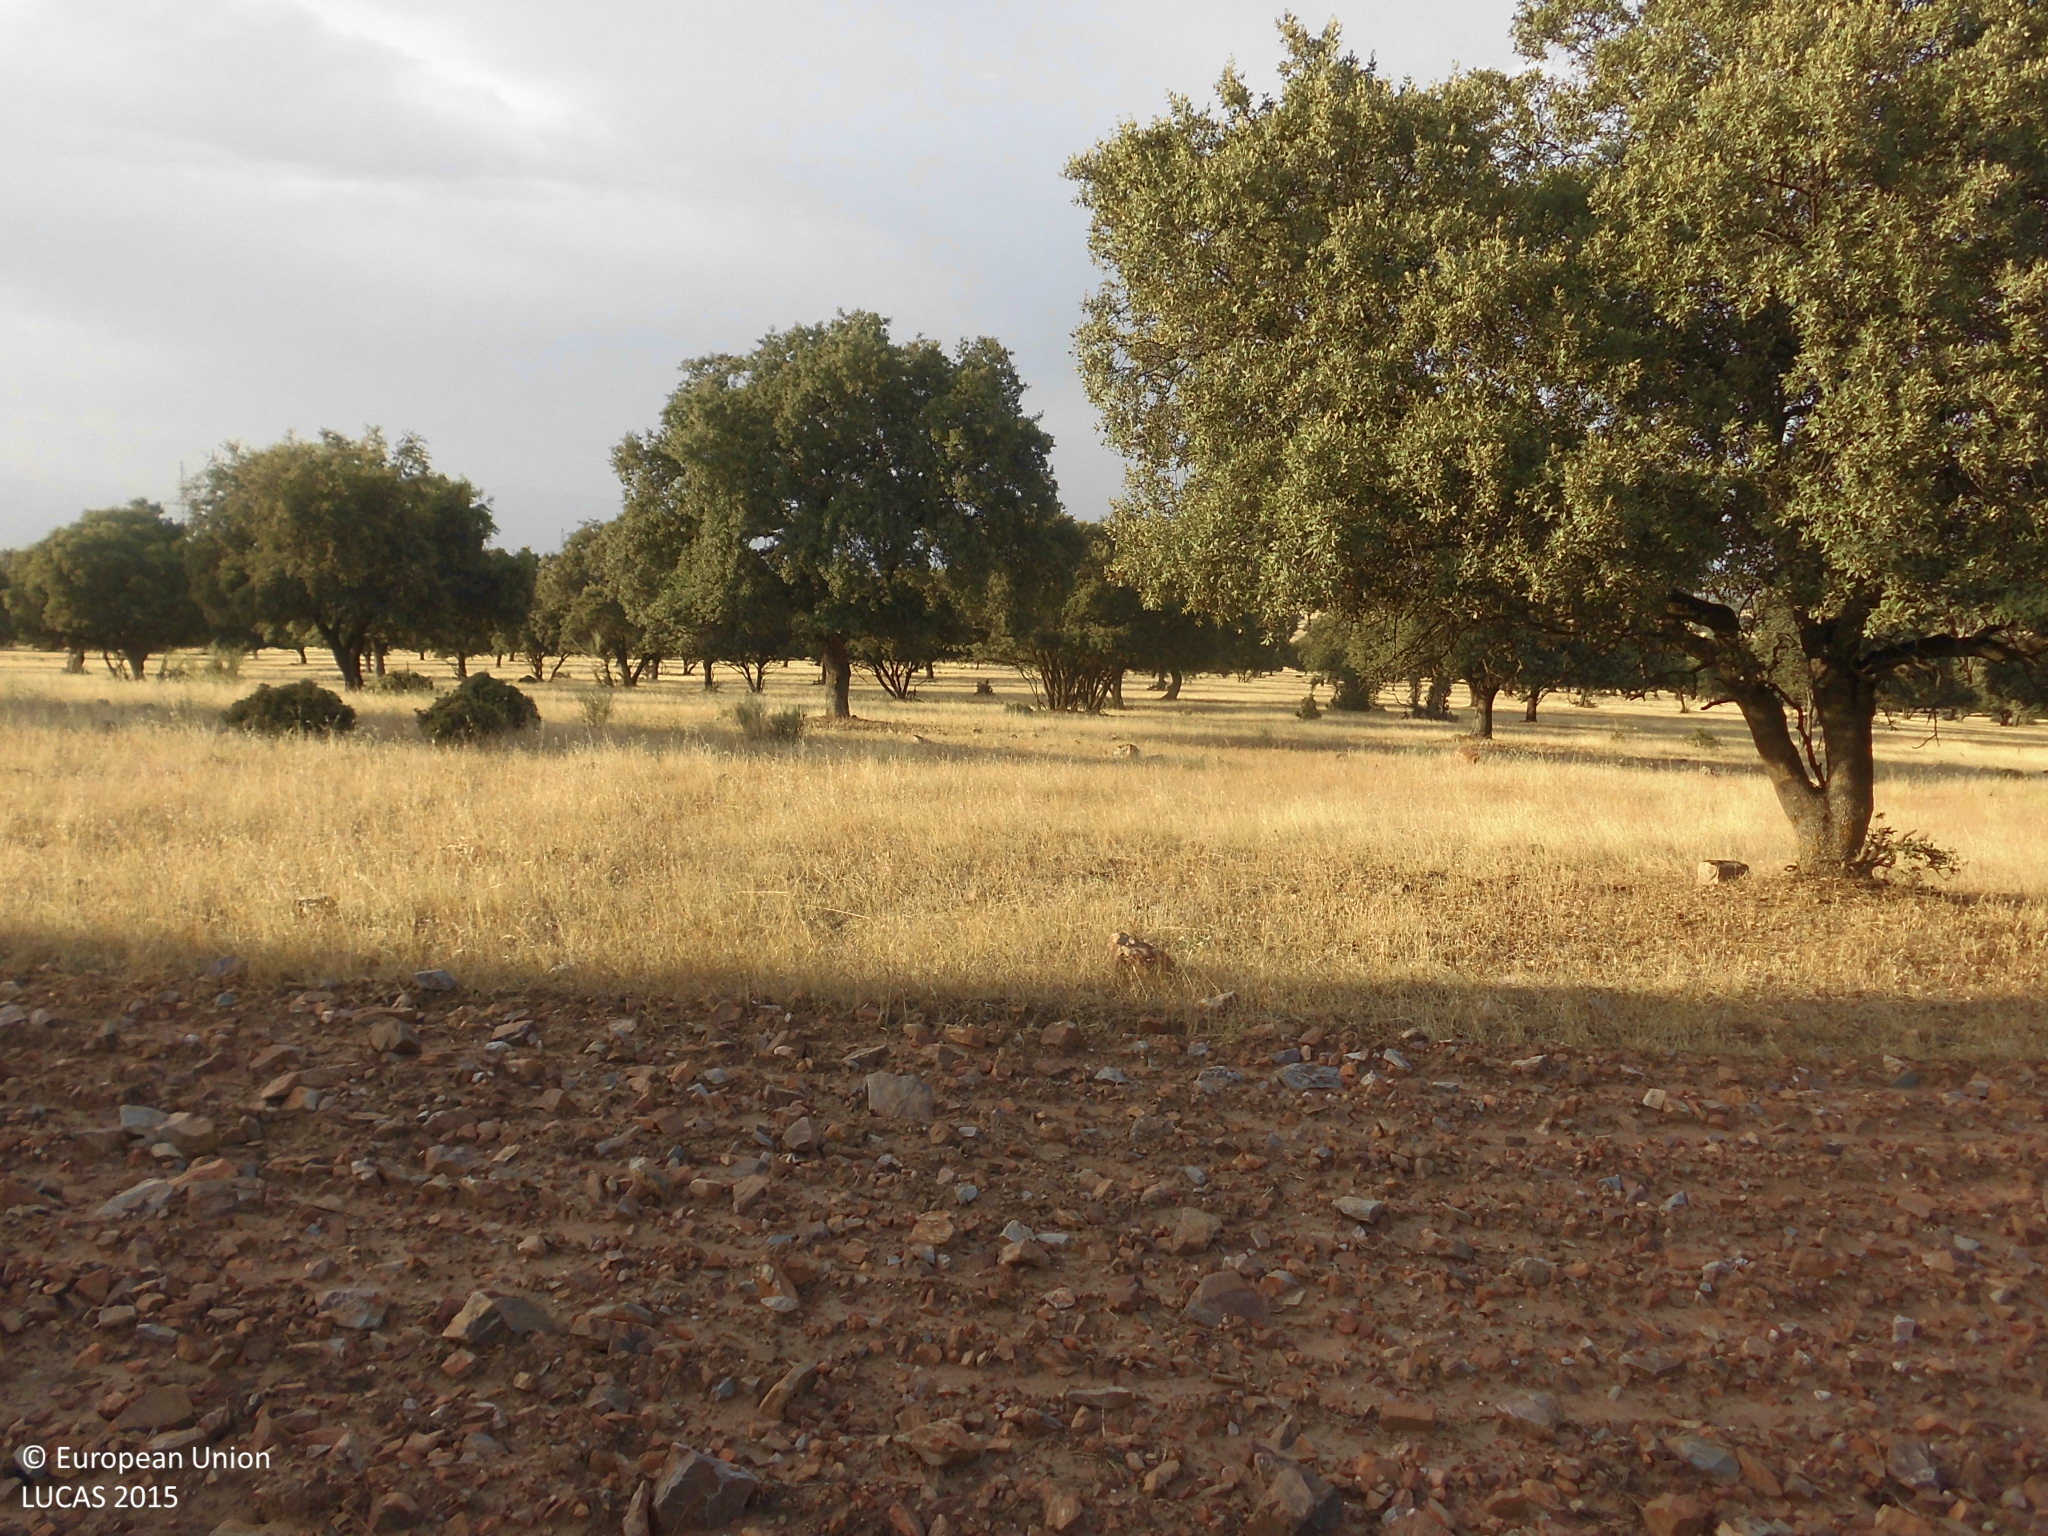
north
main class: Woodland
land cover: Broadleaved woodland
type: broadleaved evergreen forest
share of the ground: 10 - 25 %
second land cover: Grassland without tree/shrub cover
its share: > 75 %
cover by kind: herbaceous plants 65 %, broadleaved forest trees 25 %, unconsolidated bare surface 10 %
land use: Forestry
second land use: Agriculture (excluding fallow land and kitchen gardens)
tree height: > 5 m
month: July
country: ES
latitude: 39.8111
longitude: -5.6540
